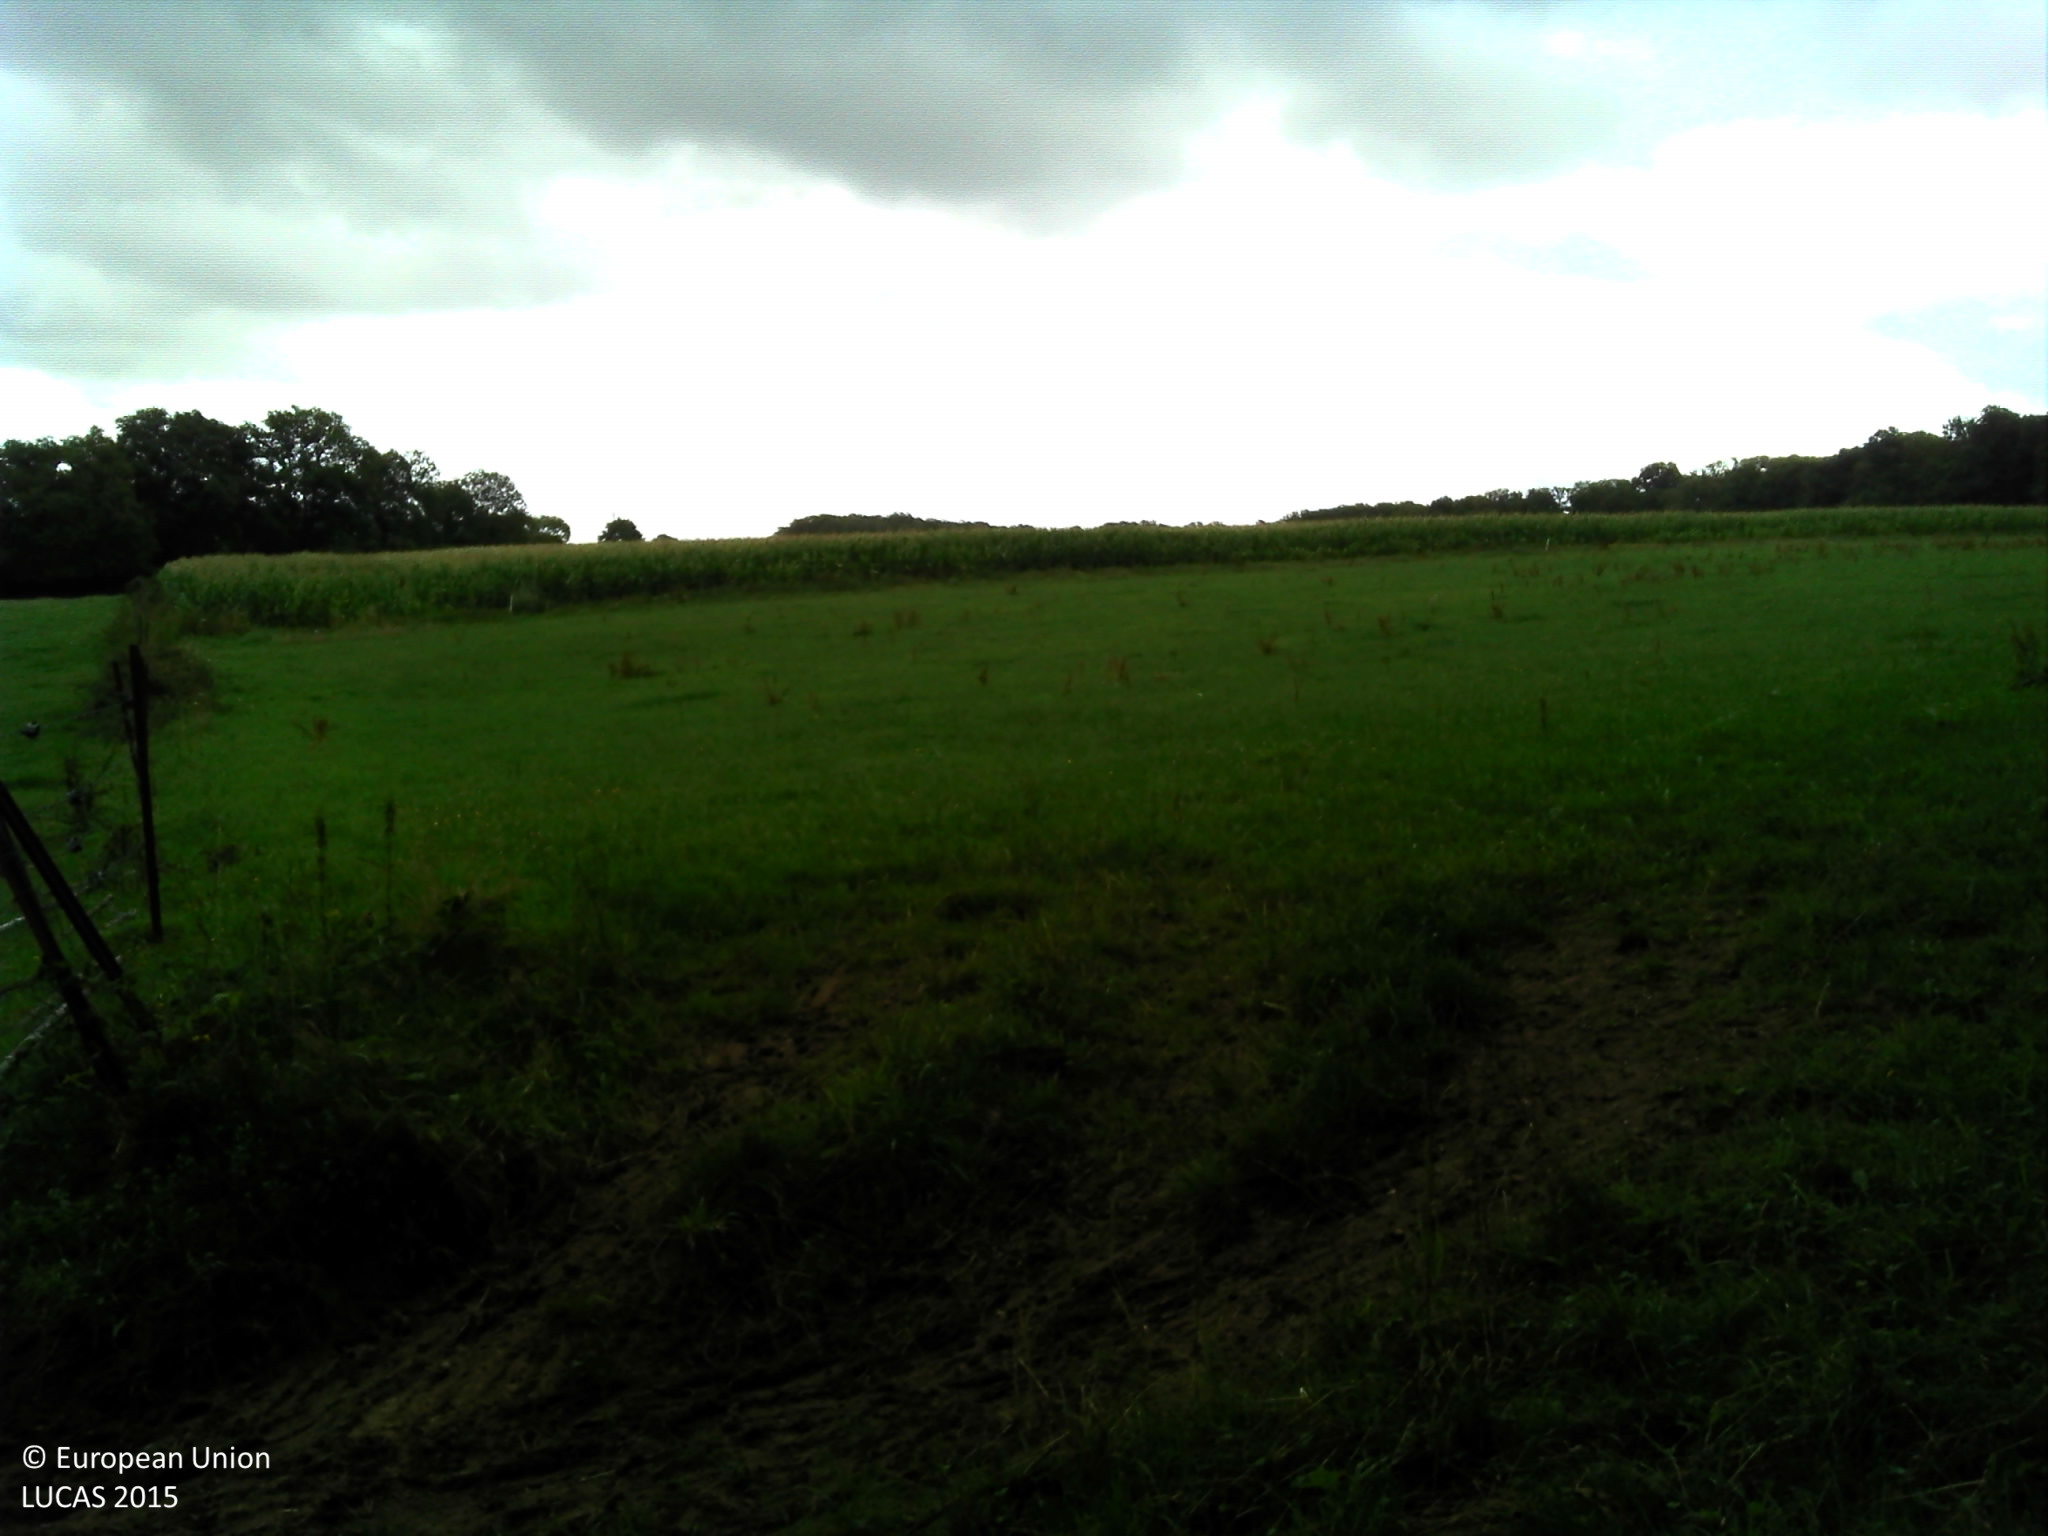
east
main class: Woodland
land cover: Broadleaved woodland
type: mesophytic deciduous forest
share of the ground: > 75 %
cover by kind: broadleaved forest trees 85 %, lichens and mosses 10 %, herbaceous plants 5 %
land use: Forestry
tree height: > 5 m
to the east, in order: Broadleaved woodland; Fences; Grassland without tree/shrub cover; Fences; Grass margins; Maize
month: August
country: FR
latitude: 50.2115
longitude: 4.0952
